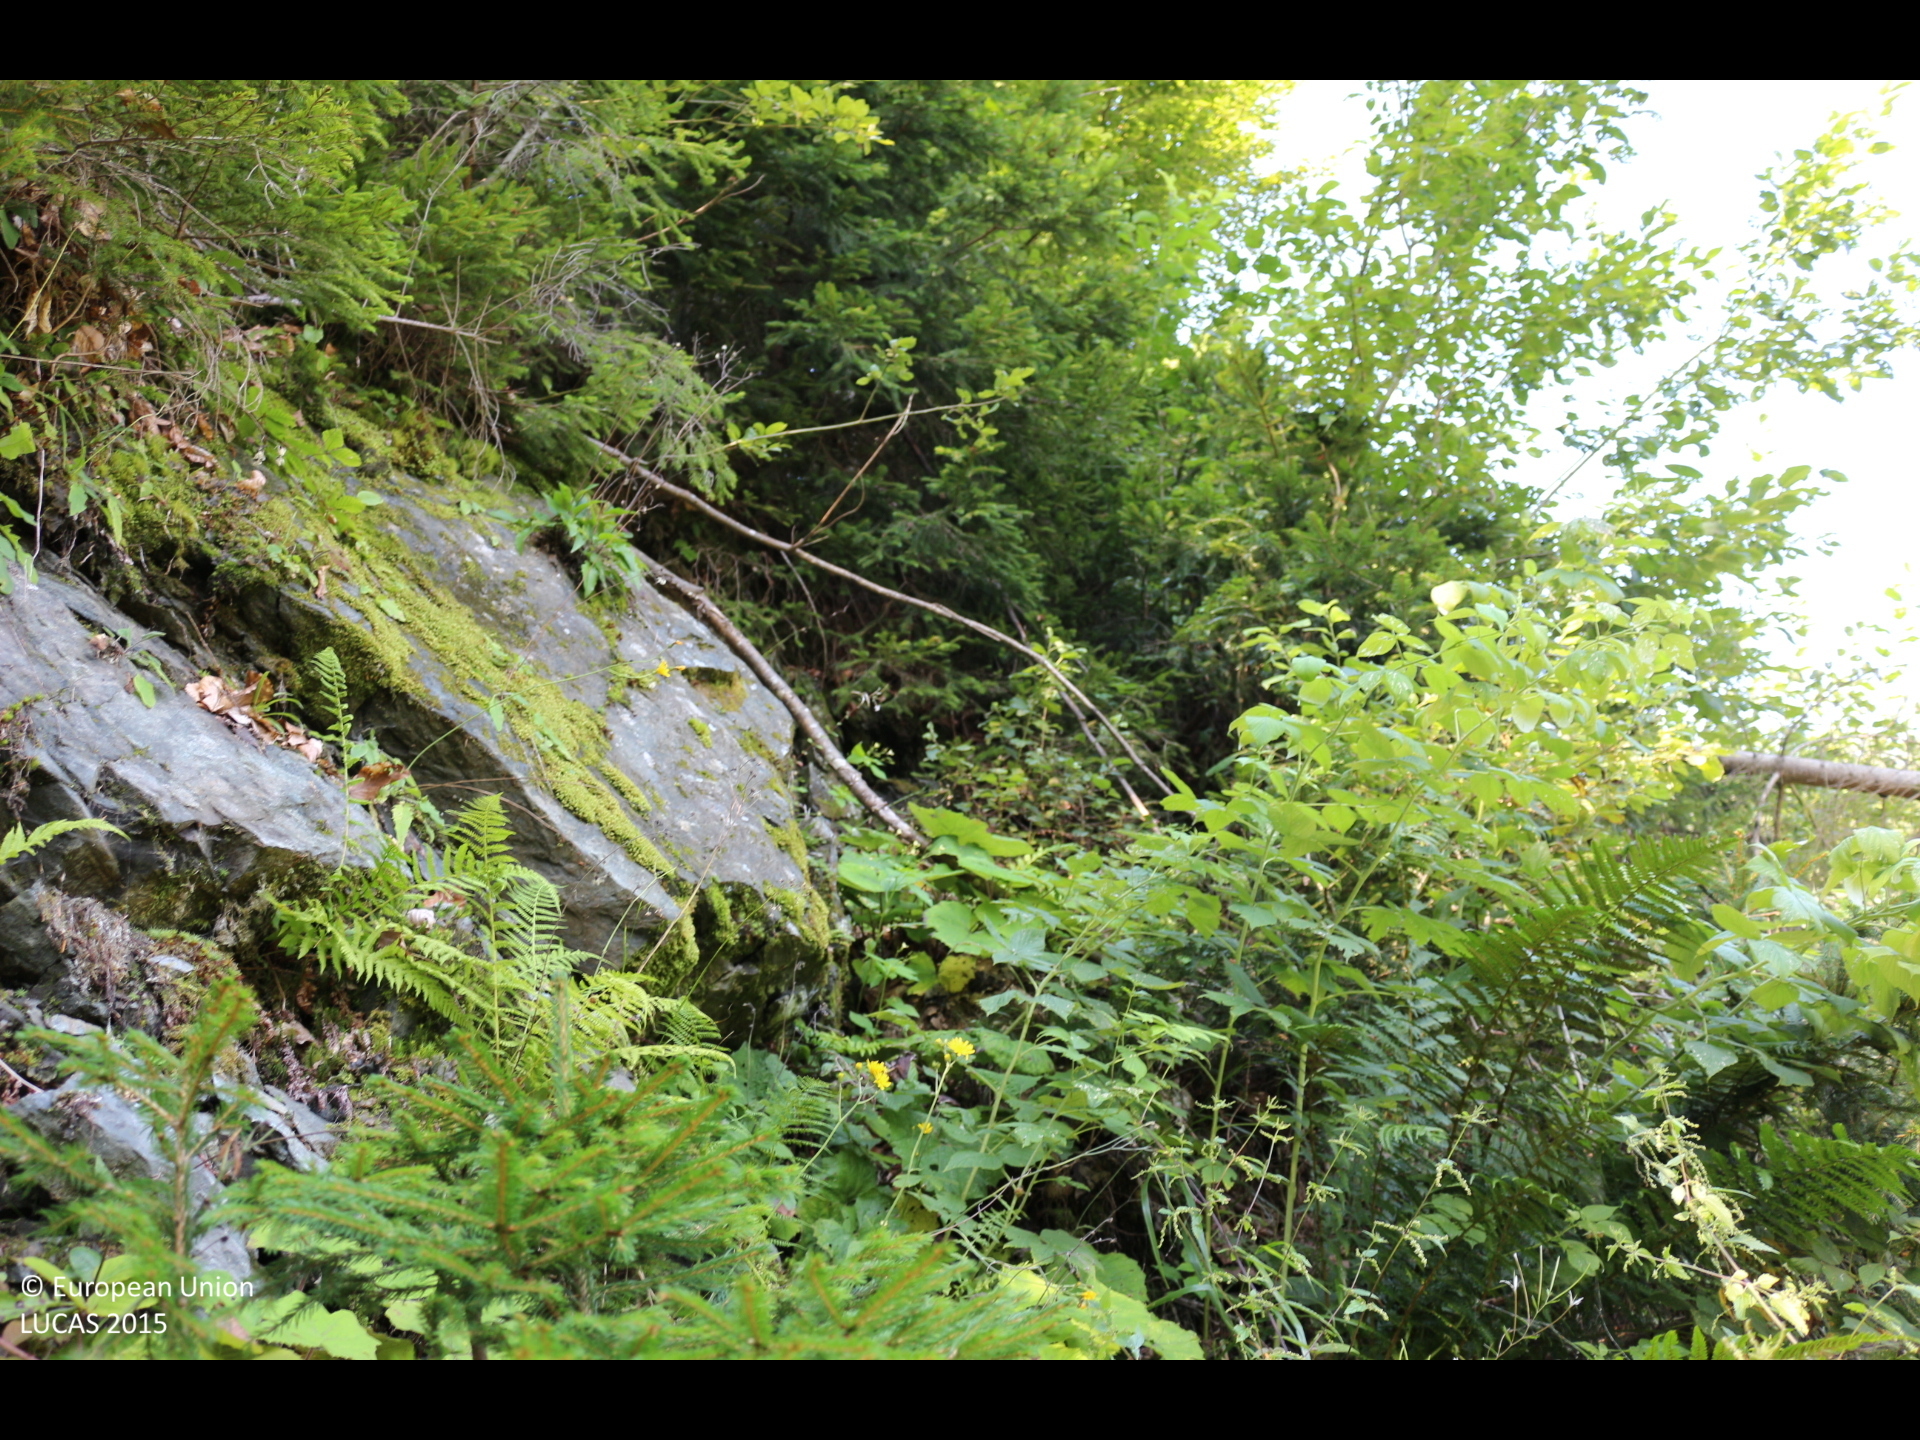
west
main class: Woodland
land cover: Spruce dominated mixed woodland
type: hemiboreal forest and nemoral coniferous forest and mixed broadleaved-coniferous forest
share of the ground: > 75 %
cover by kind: coniferous forest trees 60 %, broadleaved forest trees 40 %
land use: Forestry
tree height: > 5 m
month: August
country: AT
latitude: 46.6419
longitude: 13.3286
